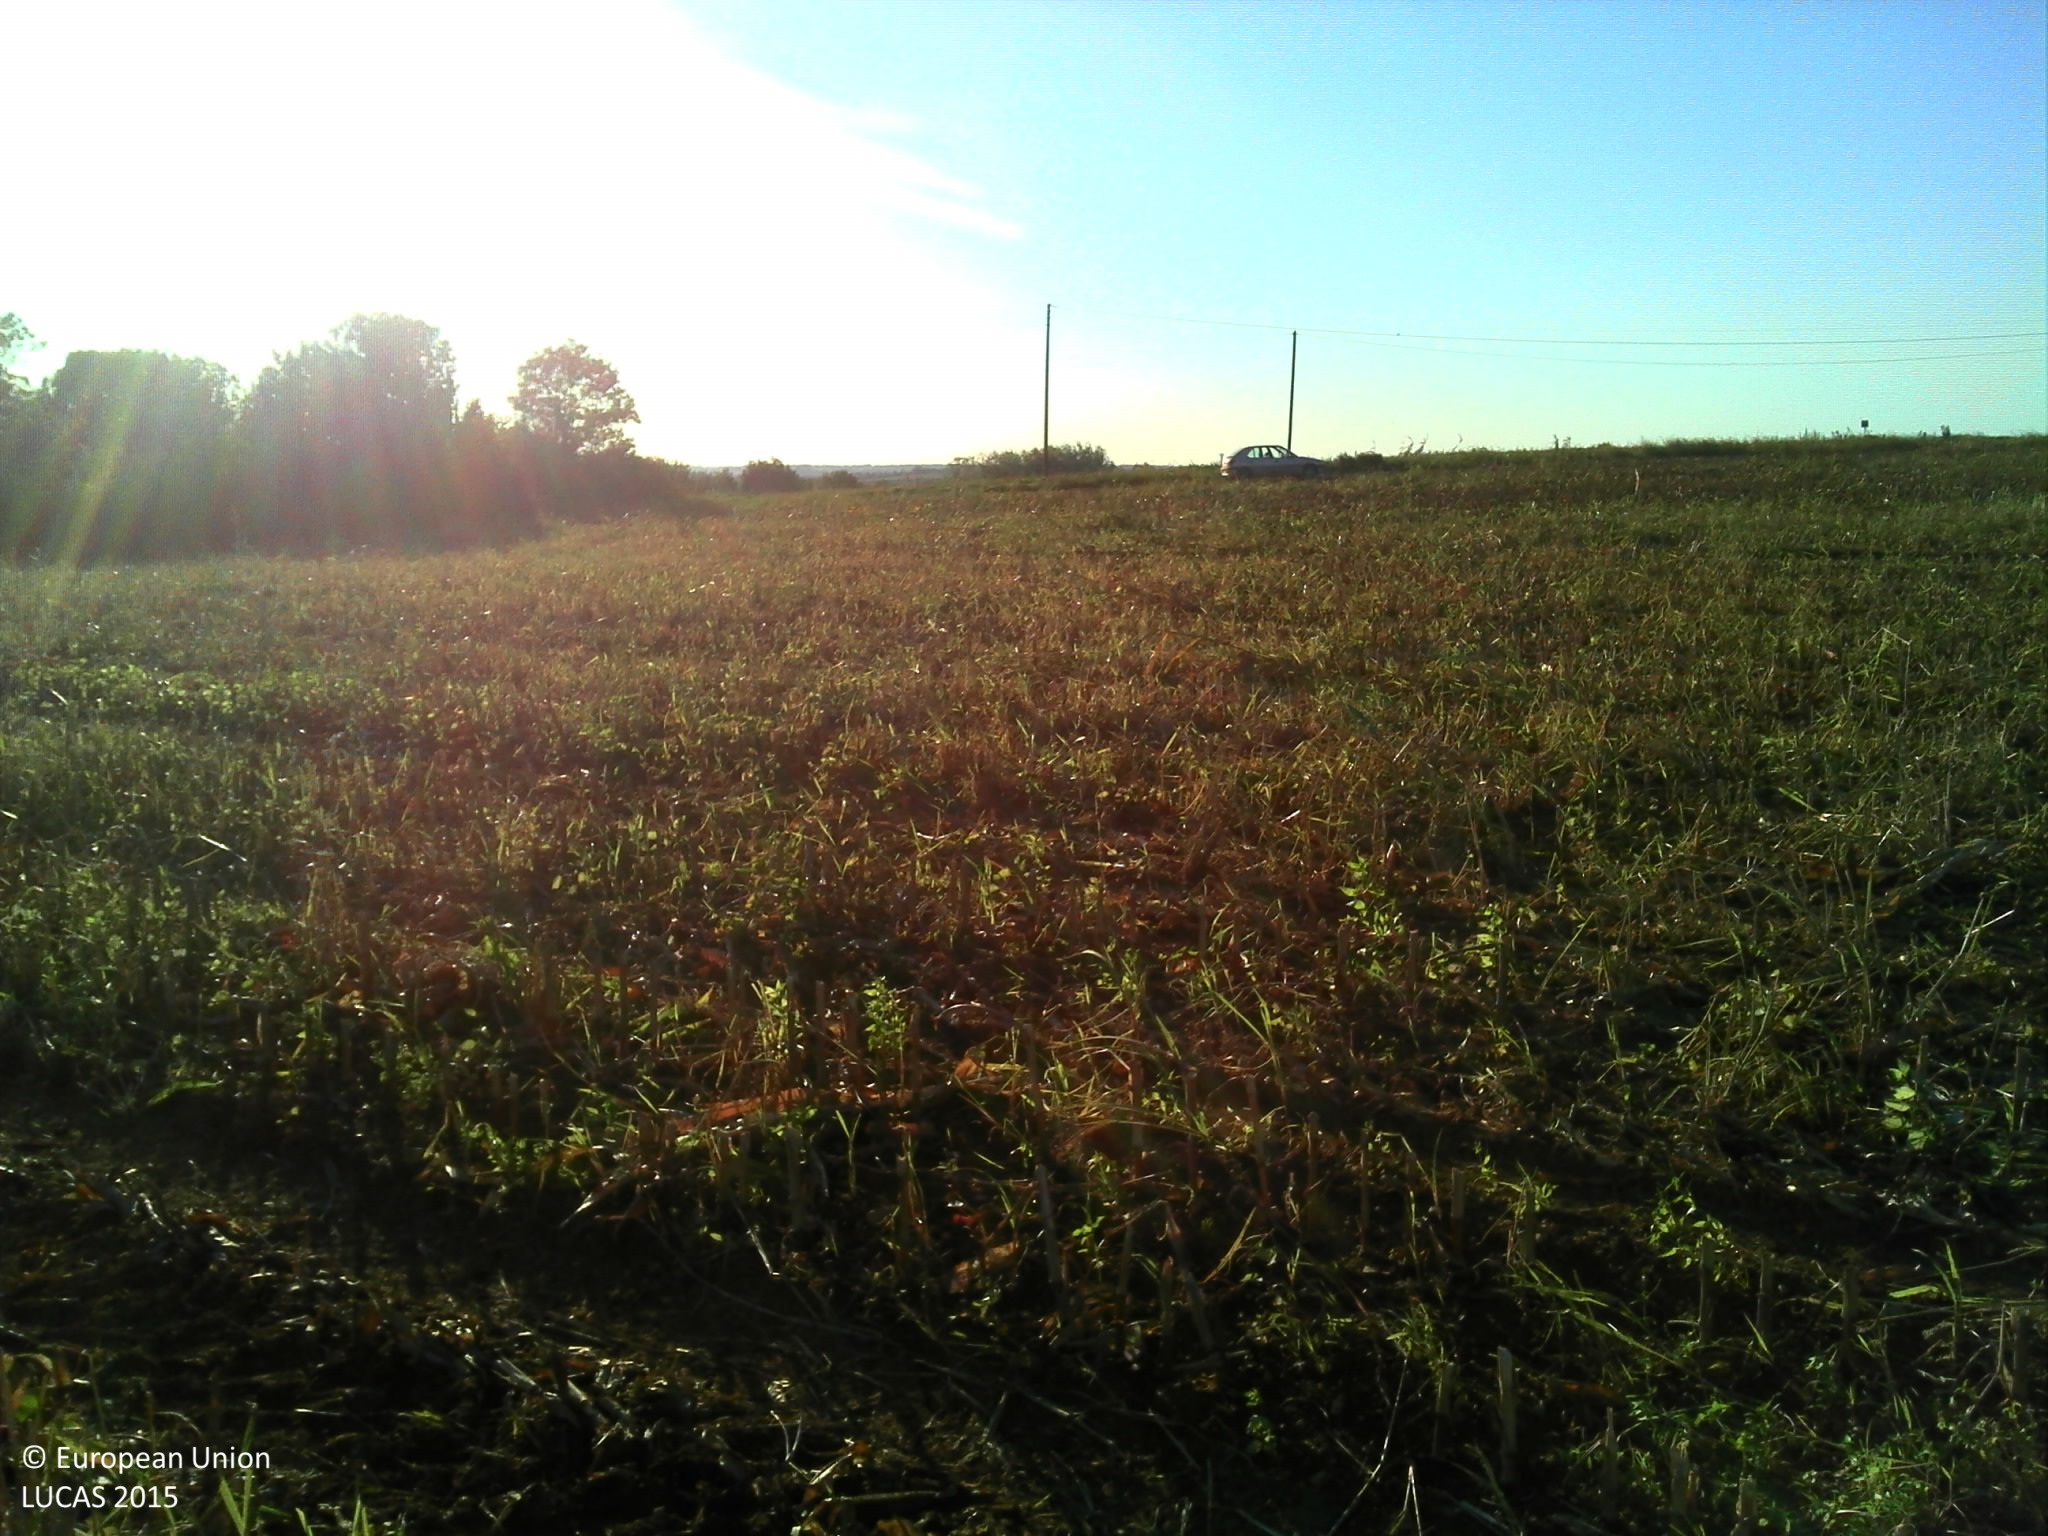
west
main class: Cropland
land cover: Maize
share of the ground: 10 - 25 %
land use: Agriculture (excluding fallow land and kitchen gardens)
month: September
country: FR
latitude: 46.4978
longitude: -1.2798
